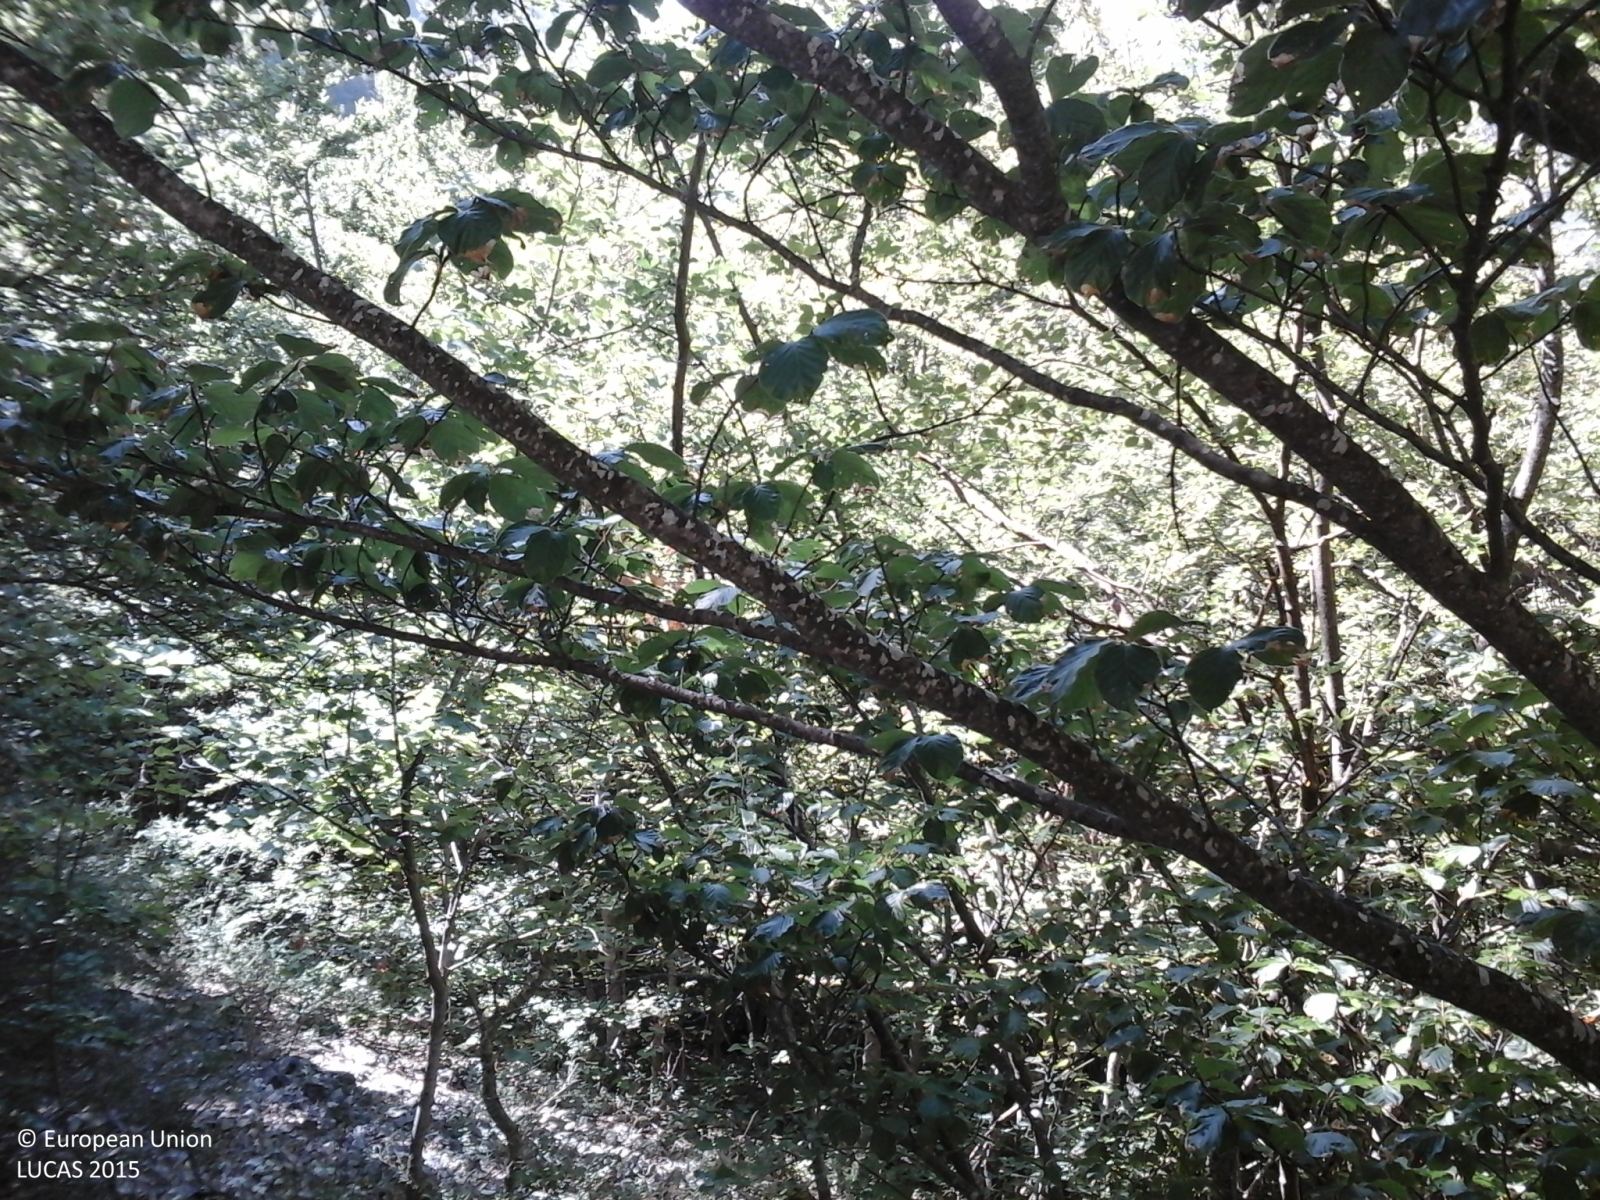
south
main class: Woodland
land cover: Broadleaved woodland
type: mountainous beech forest
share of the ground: > 75 %
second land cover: Grassland without tree/shrub cover
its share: < 10 %
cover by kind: broadleaved forest trees 90 %, herbaceous plants 10 %
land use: Forestry
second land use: Agriculture (excluding fallow land and kitchen gardens)
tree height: > 5 m
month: August
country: IT
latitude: 42.8577
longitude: 13.1605
